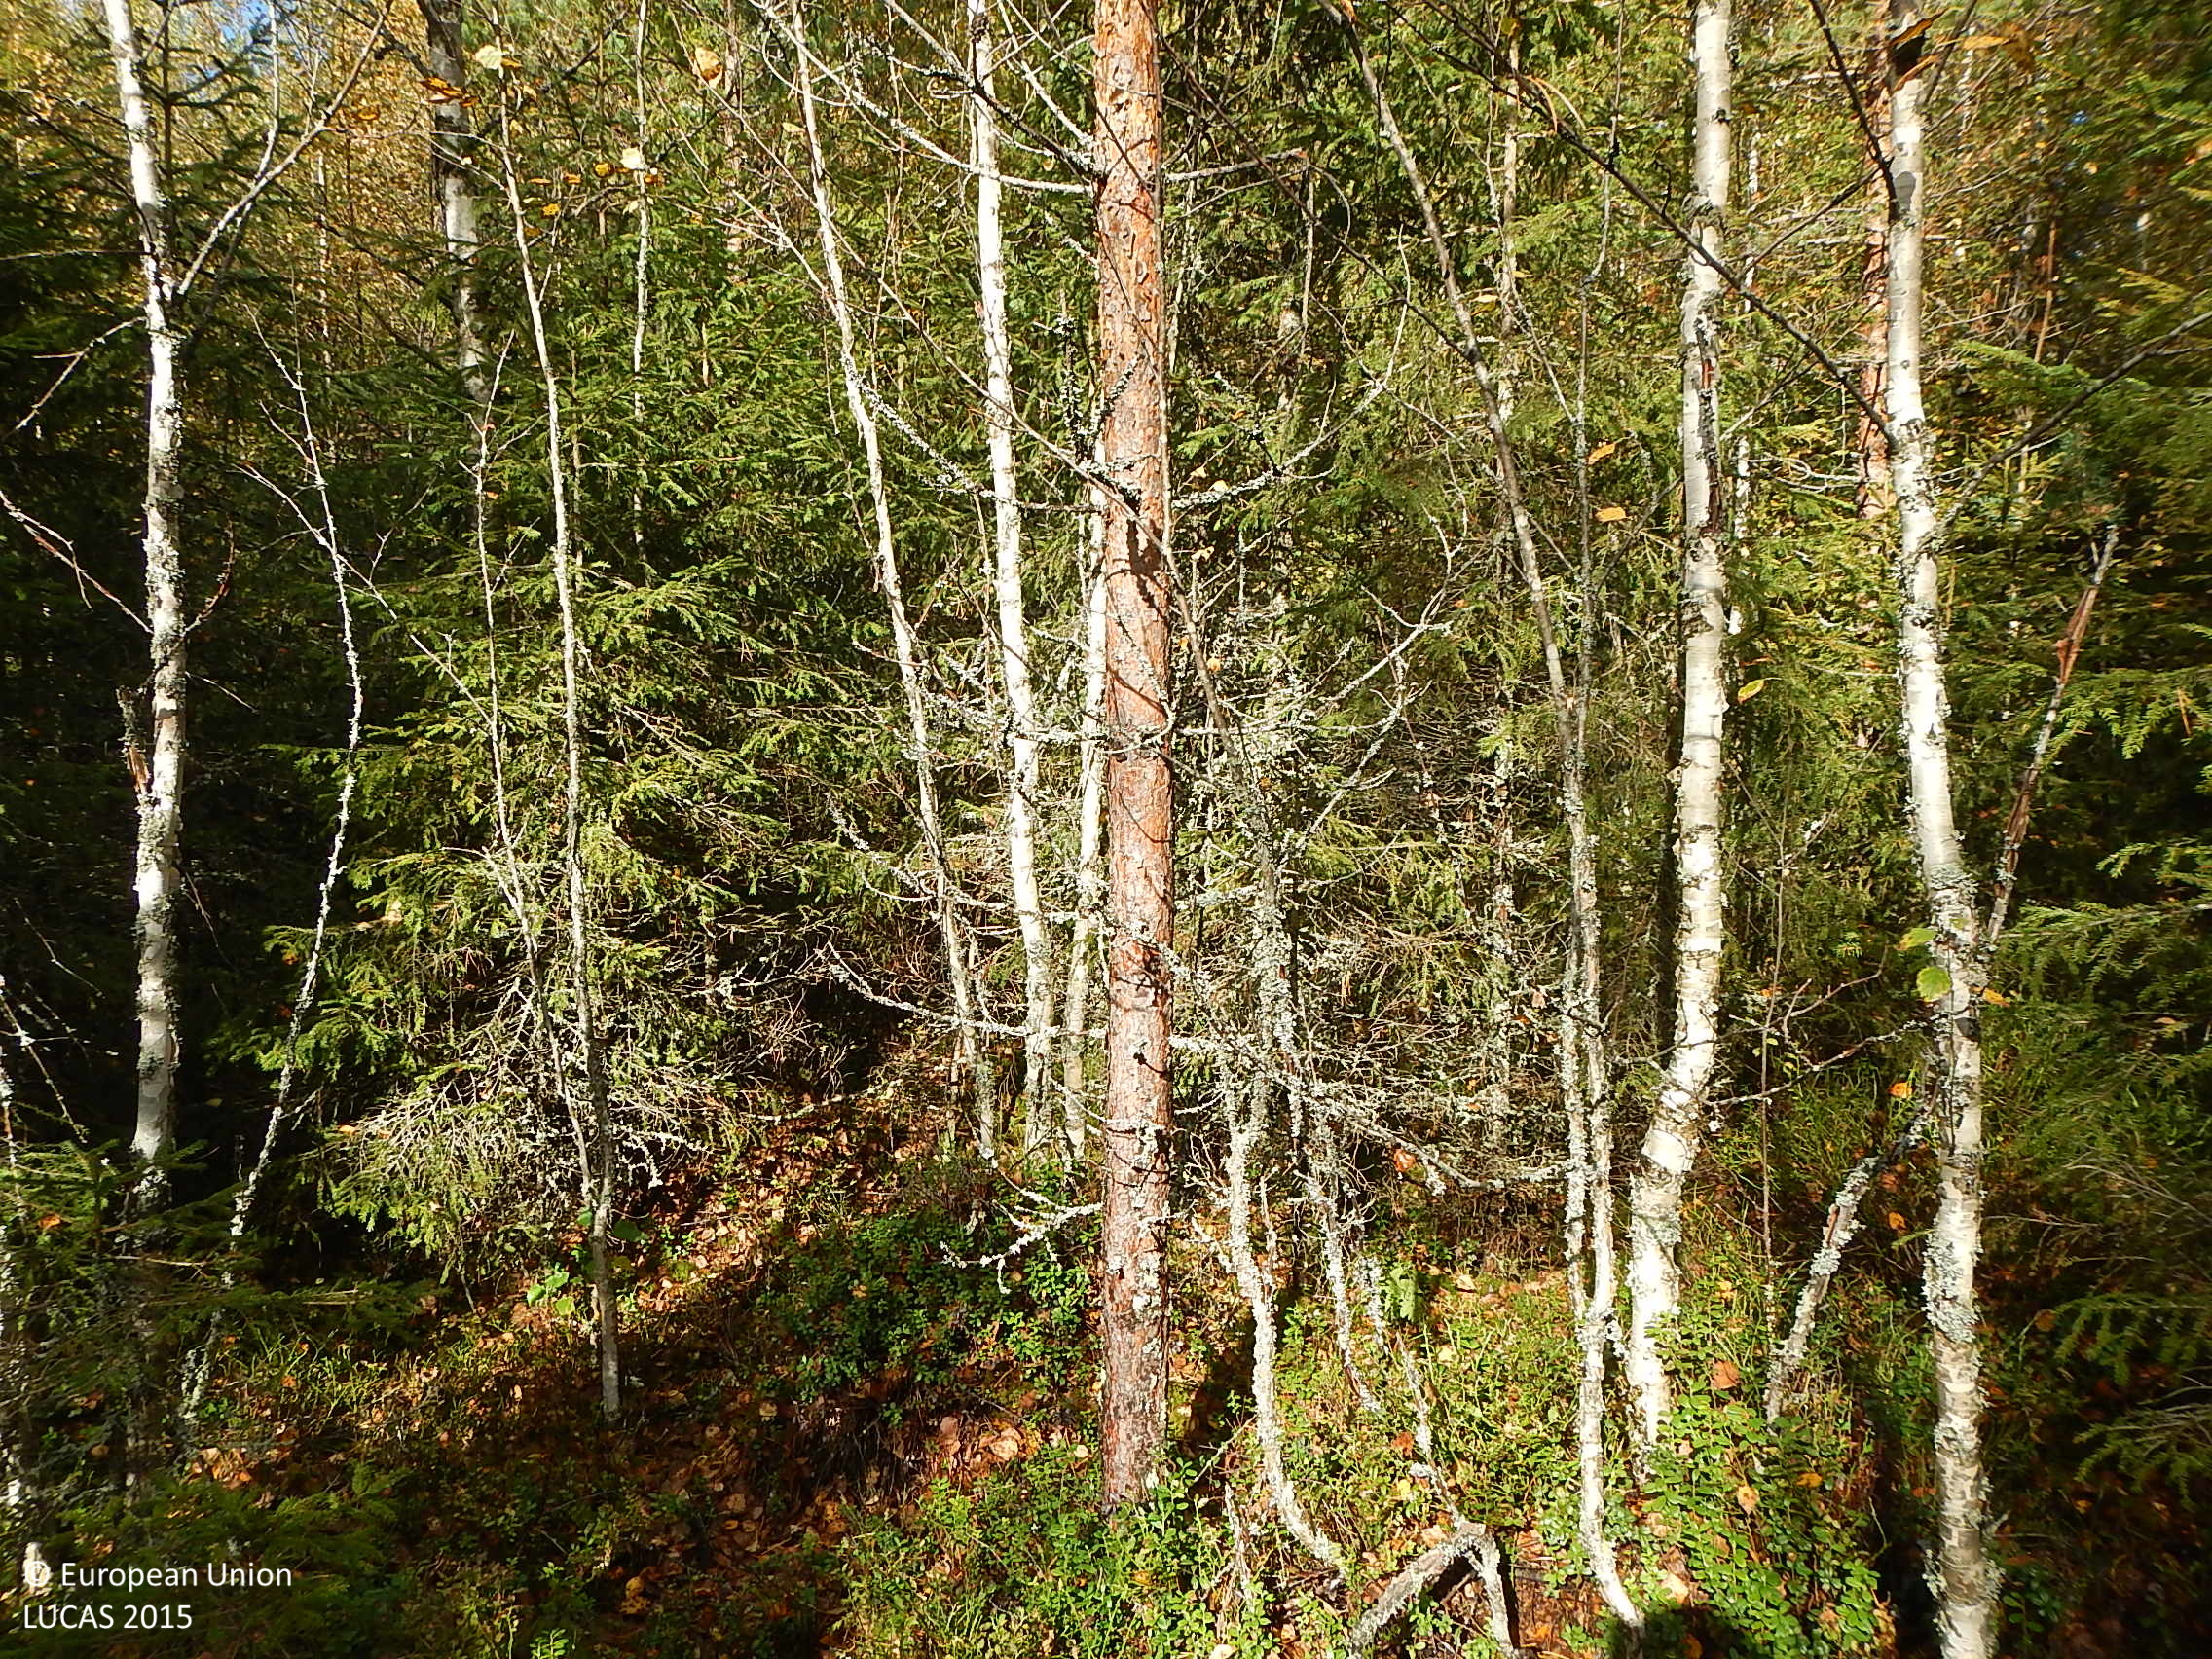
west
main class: Woodland
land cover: Other mixed woodland
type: boreal forest
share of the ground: 50 - 75 %
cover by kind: broadleaved forest trees 40 %, coniferous forest trees 30 %, shrubs 20 %, lichens and mosses 10 %
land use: Forestry
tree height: > 5 m
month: September
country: FI
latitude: 61.8571
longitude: 22.4320
